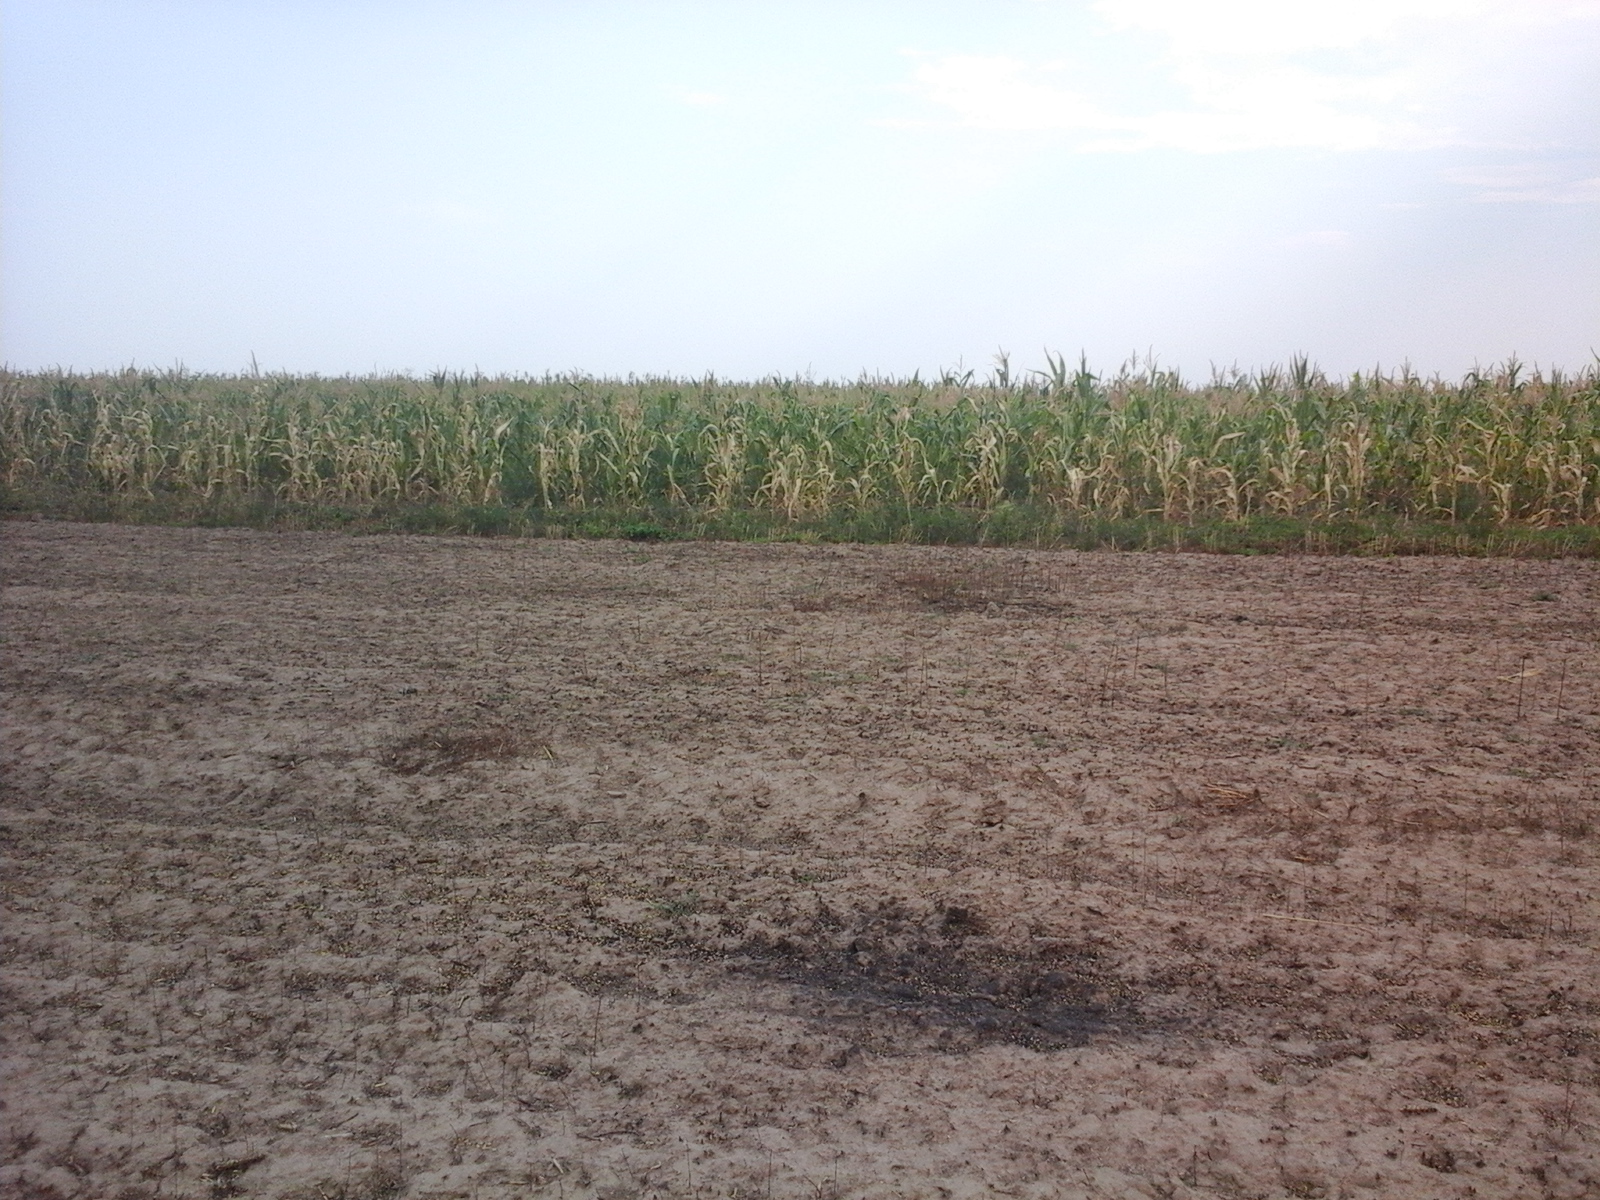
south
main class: Cropland
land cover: Durum wheat
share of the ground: < 10 %
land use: Agriculture (excluding fallow land and kitchen gardens)
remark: Burnt area
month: August
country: RO
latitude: 44.4014
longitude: 22.7348
